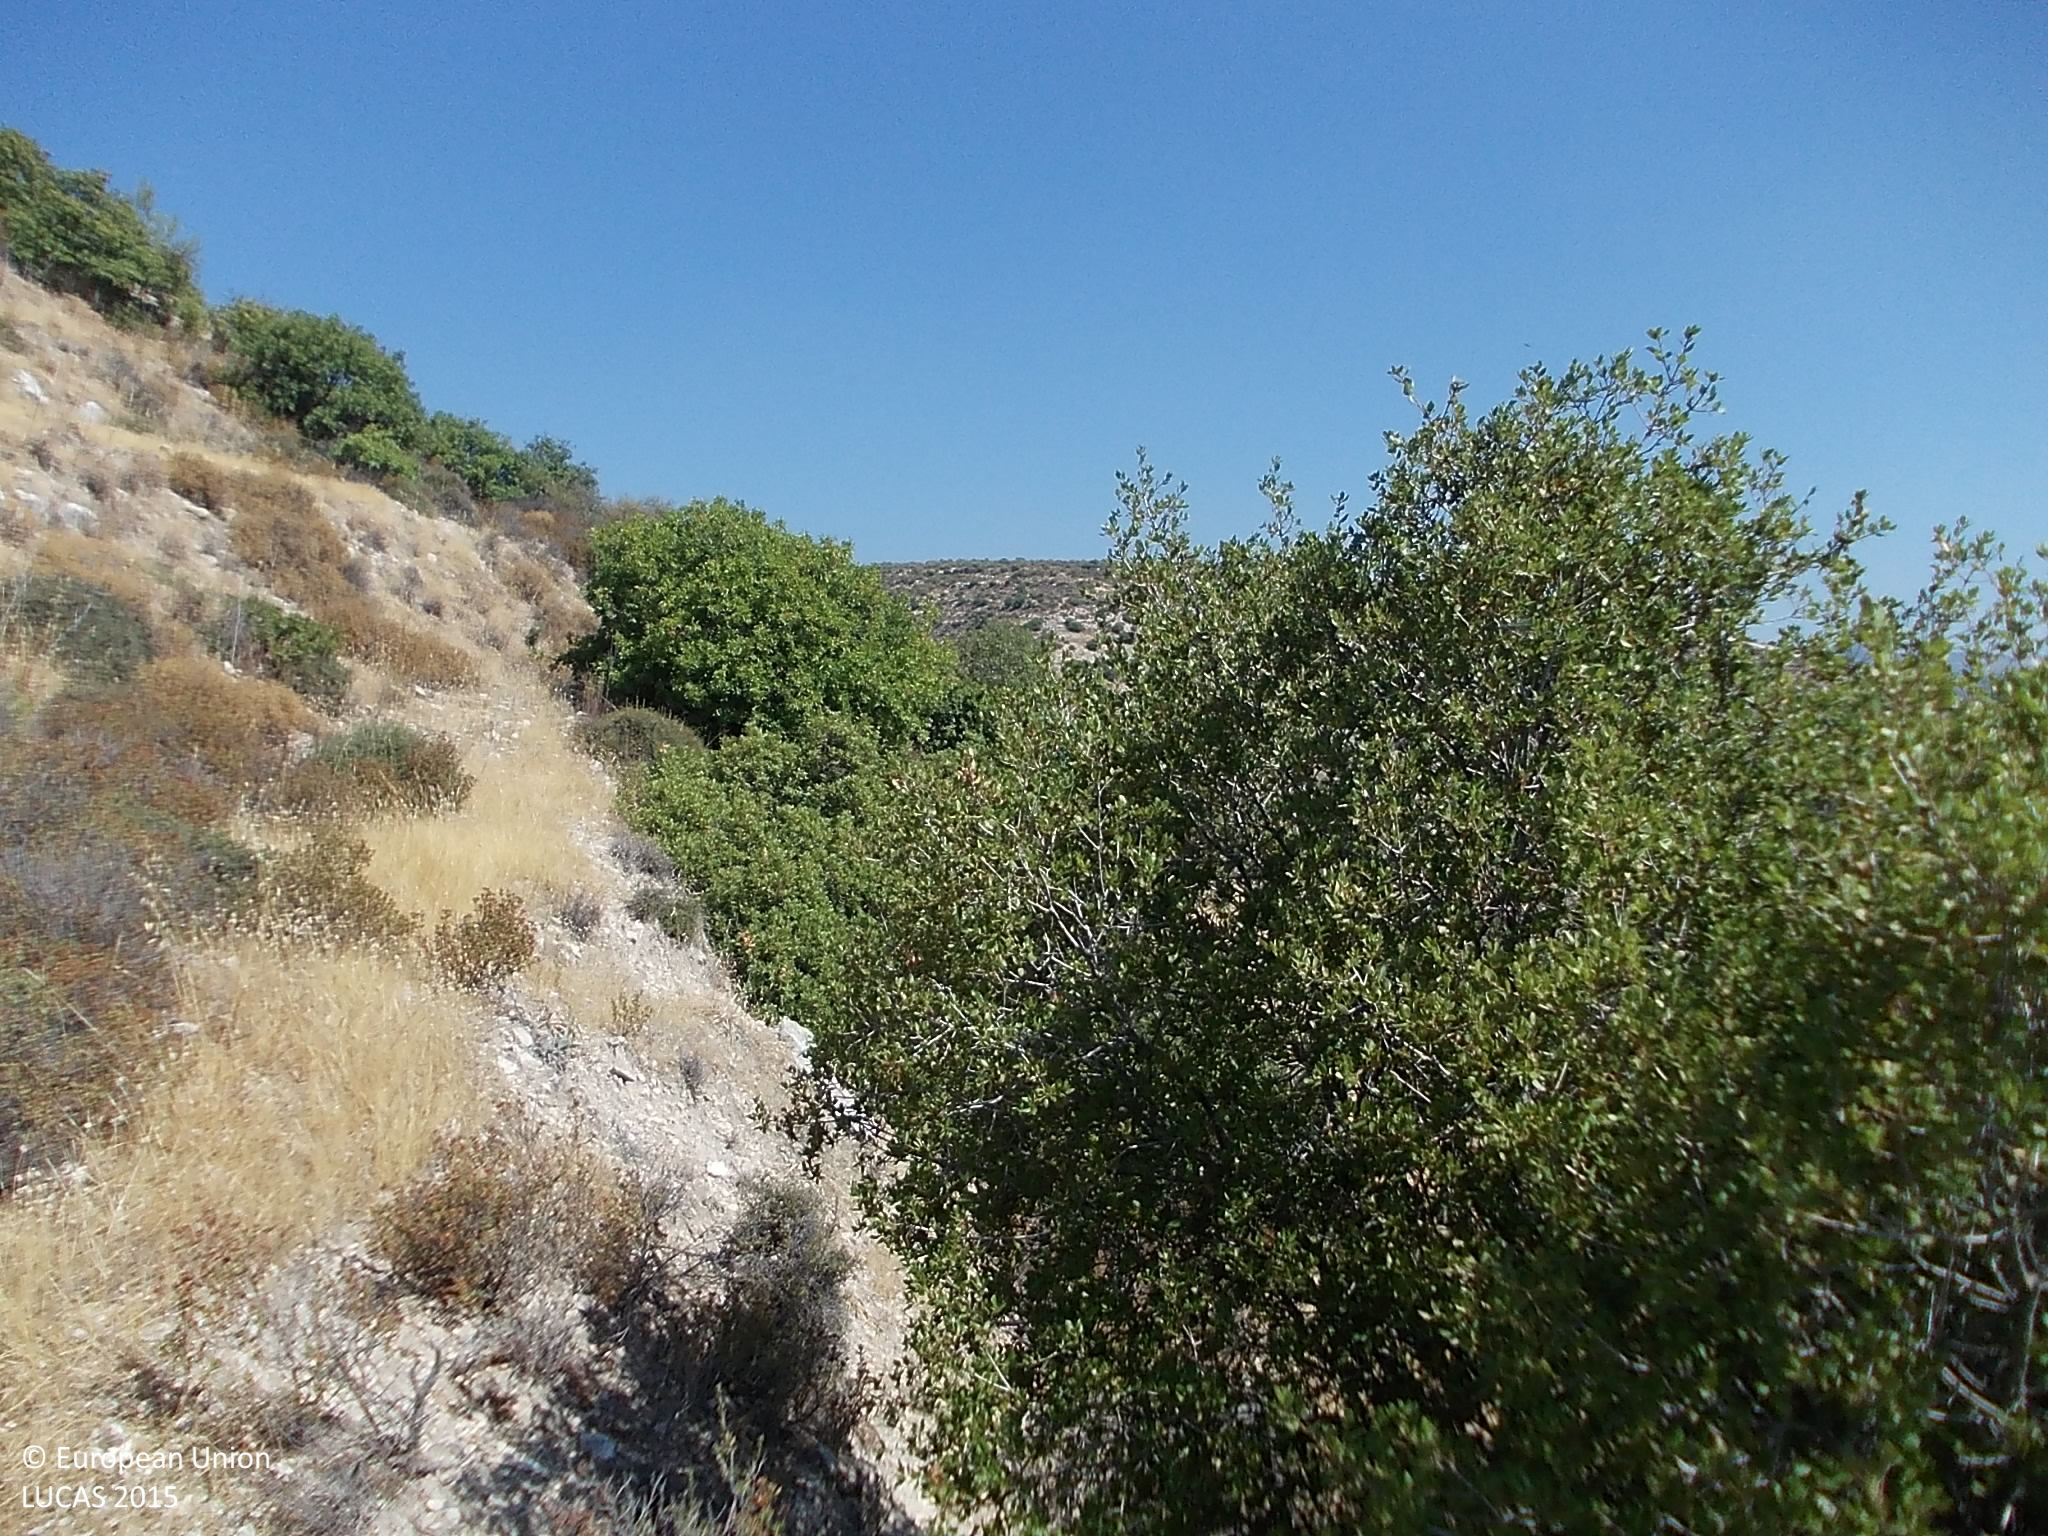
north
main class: Shrubland
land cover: Shrubland with sparse tree cover
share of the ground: > 75 %
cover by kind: shrubs 90 %, coniferous forest trees 5 %, unconsolidated bare surface 5 %
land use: Semi-natural and natural areas not in use
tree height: > 5 m
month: August
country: CY
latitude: 34.7811
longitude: 32.9034
